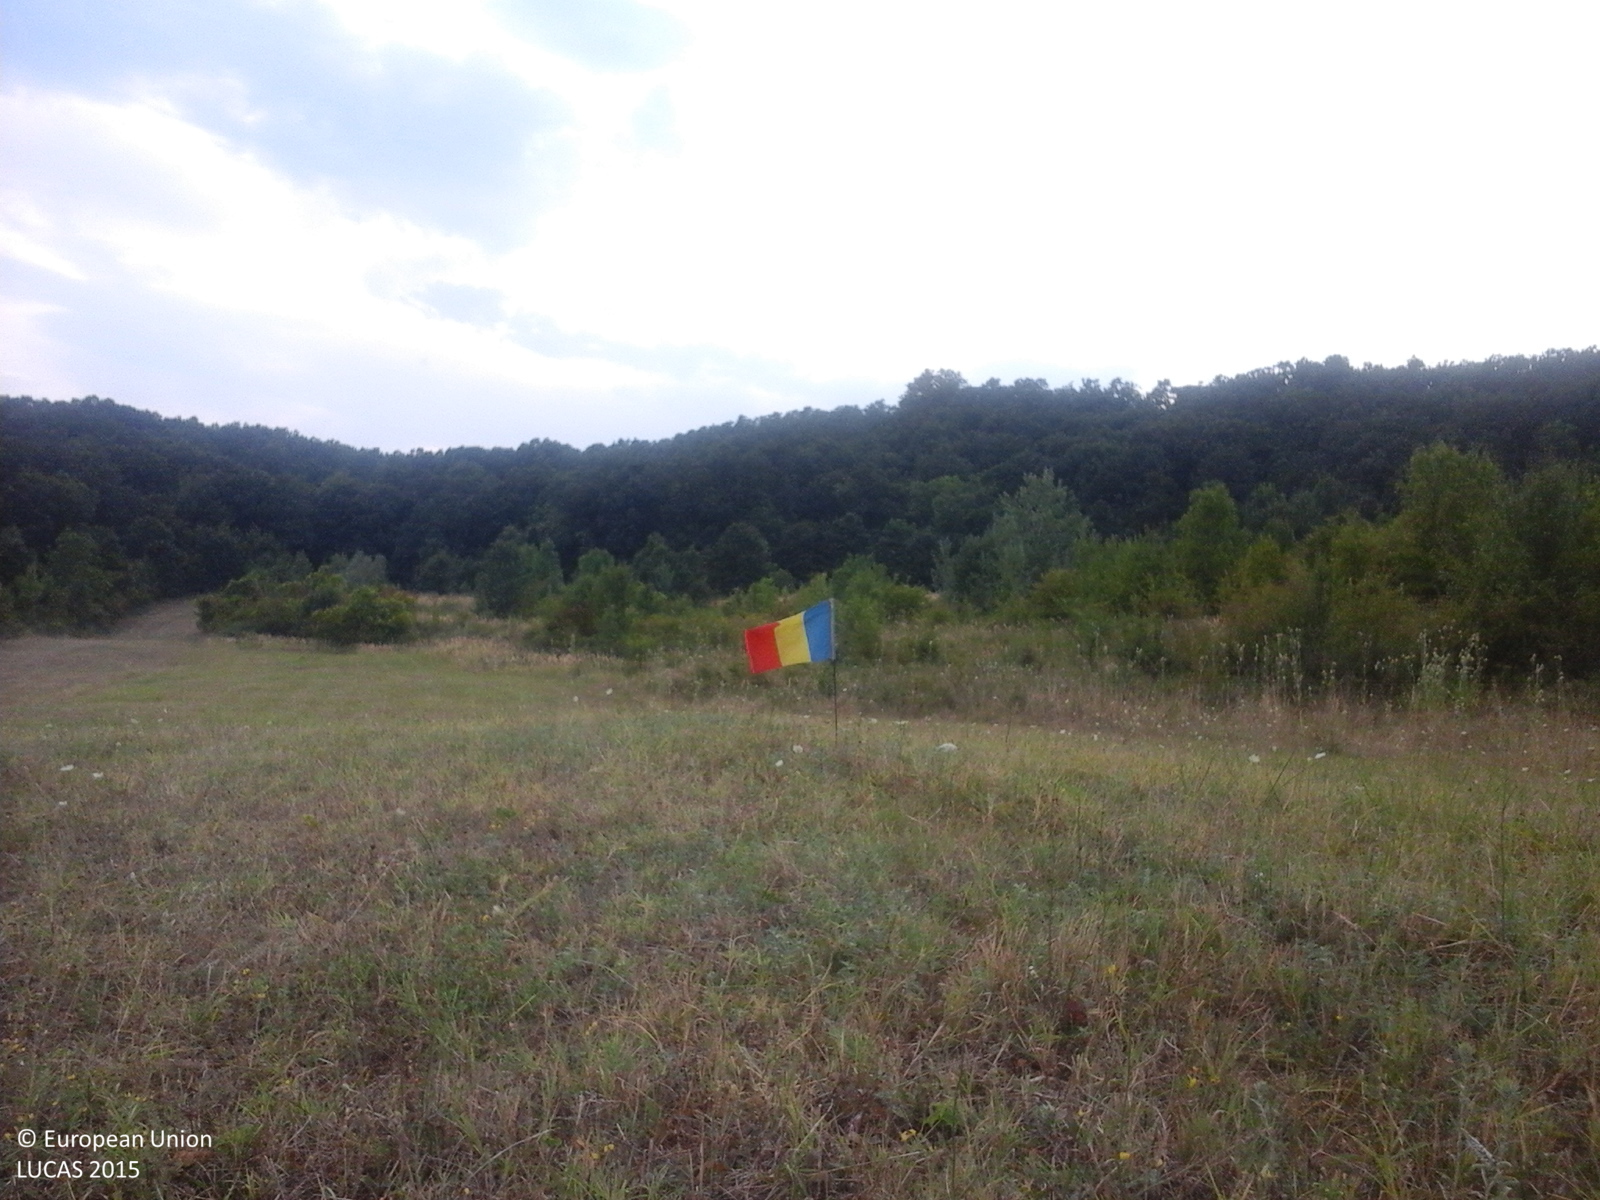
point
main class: Grassland
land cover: Grassland without tree/shrub cover
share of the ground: > 75 %
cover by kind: herbaceous plants 100 %
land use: Agriculture (excluding fallow land and kitchen gardens)
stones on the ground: < 10 %
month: August
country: RO
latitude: 44.6718
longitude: 23.0527
